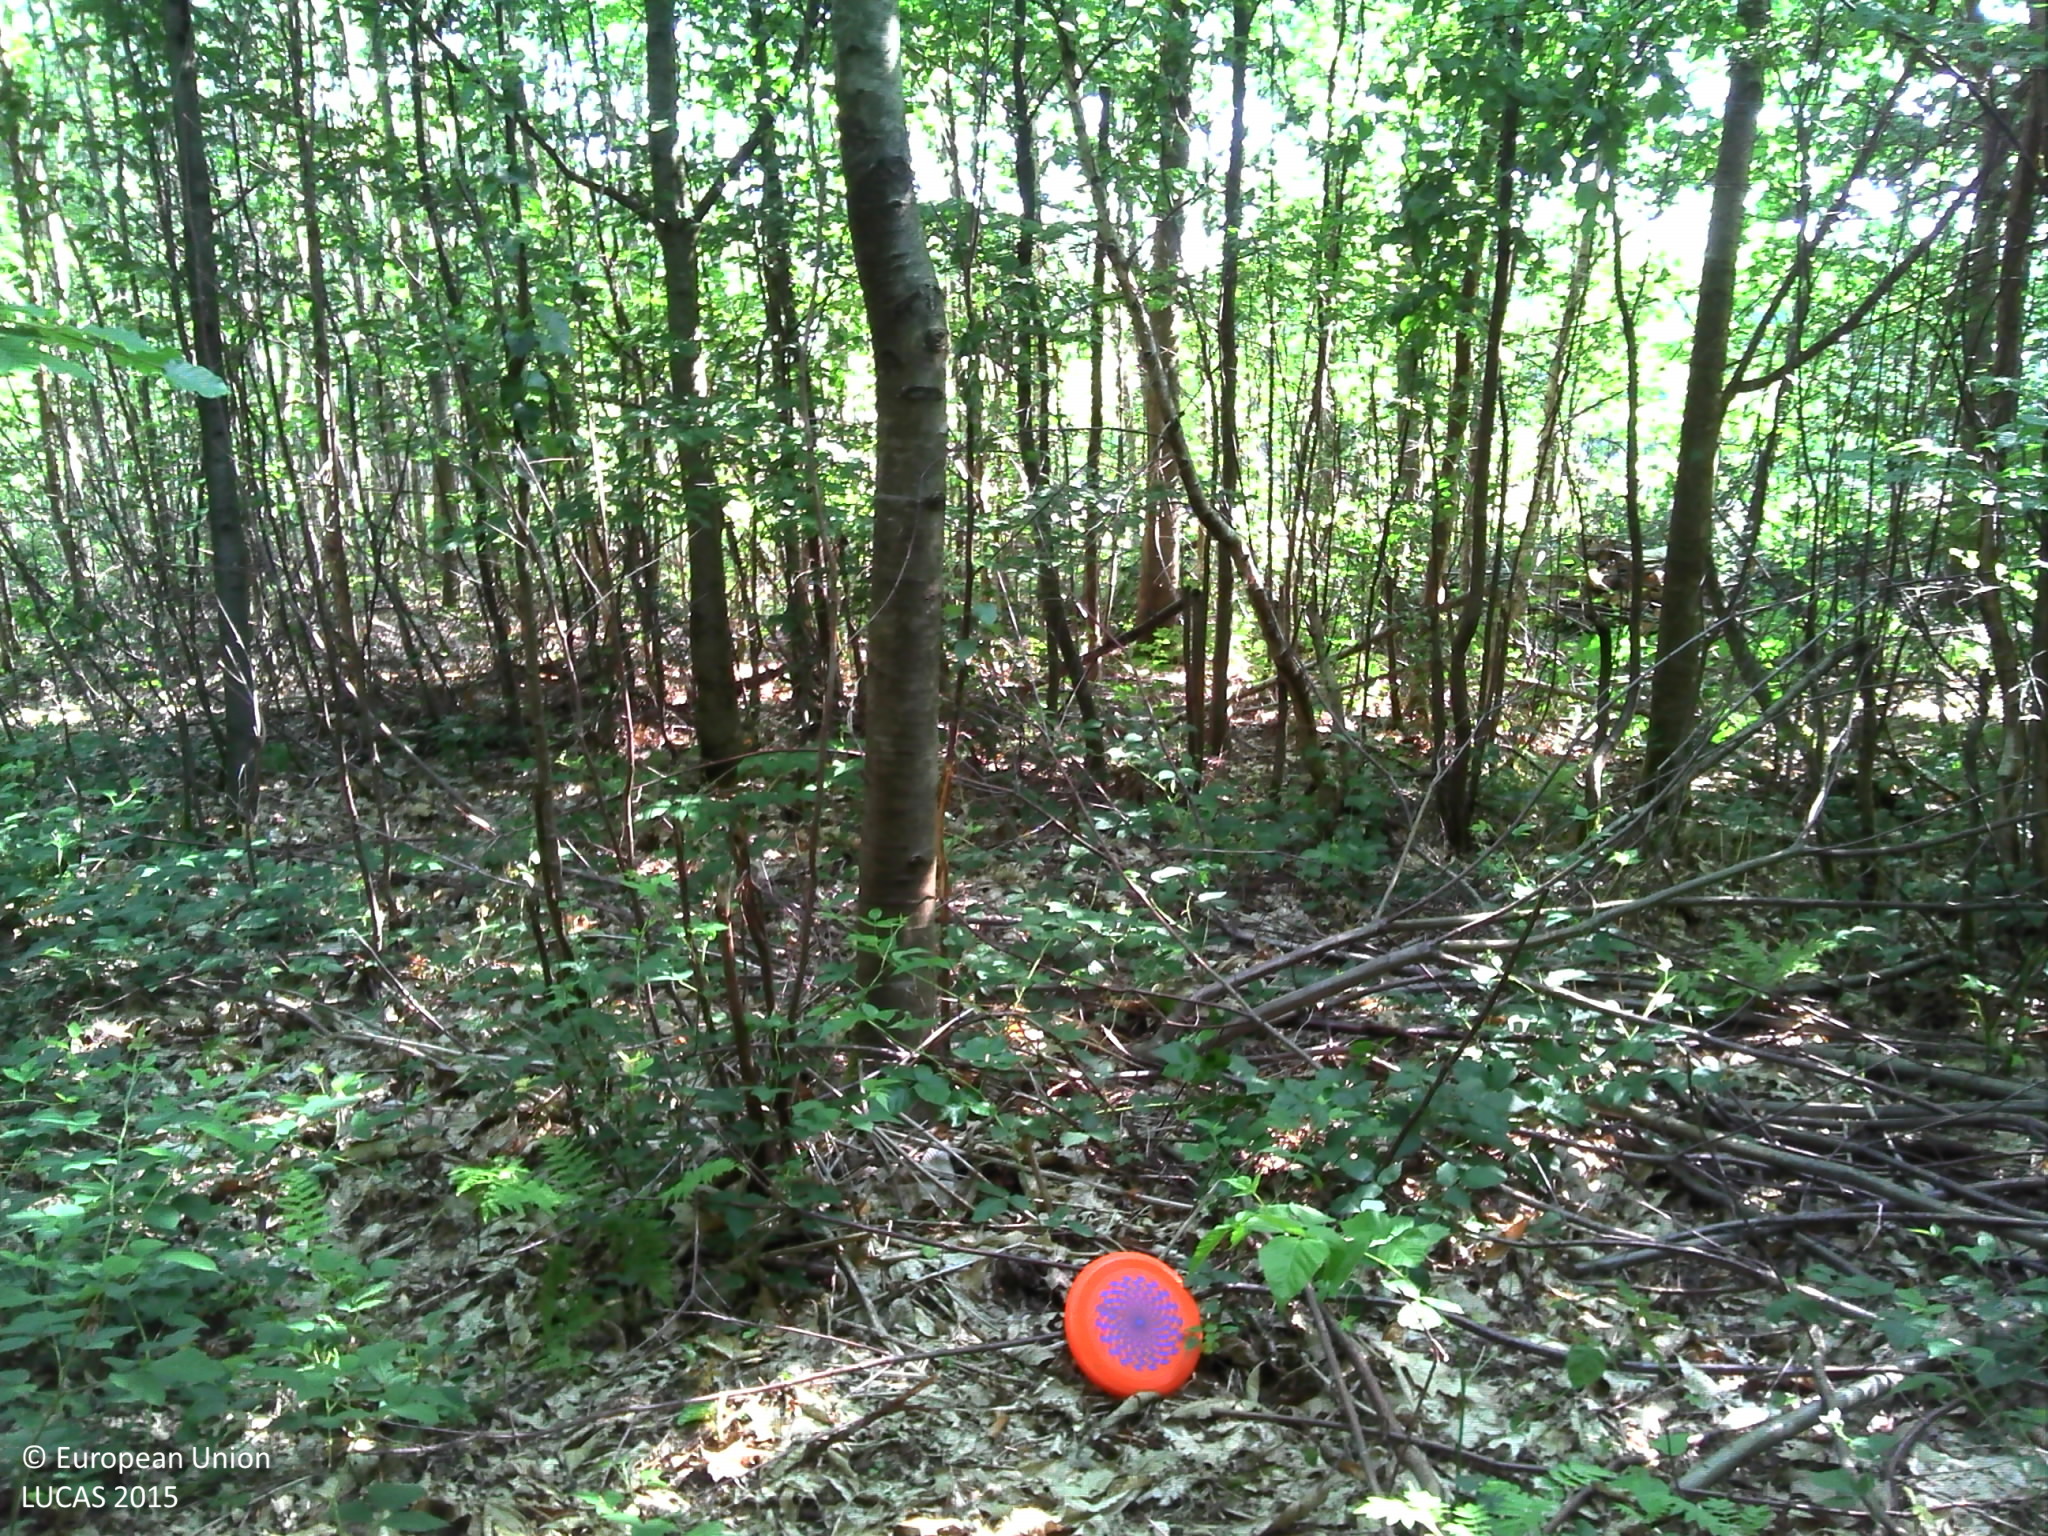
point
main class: Woodland
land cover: Broadleaved woodland
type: exotic forest
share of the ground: > 75 %
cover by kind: broadleaved forest trees 85 %, herbaceous plants 10 %, unconsolidated bare surface 5 %
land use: Forestry
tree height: > 5 m
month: July
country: BE
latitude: 50.2876
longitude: 4.5363
